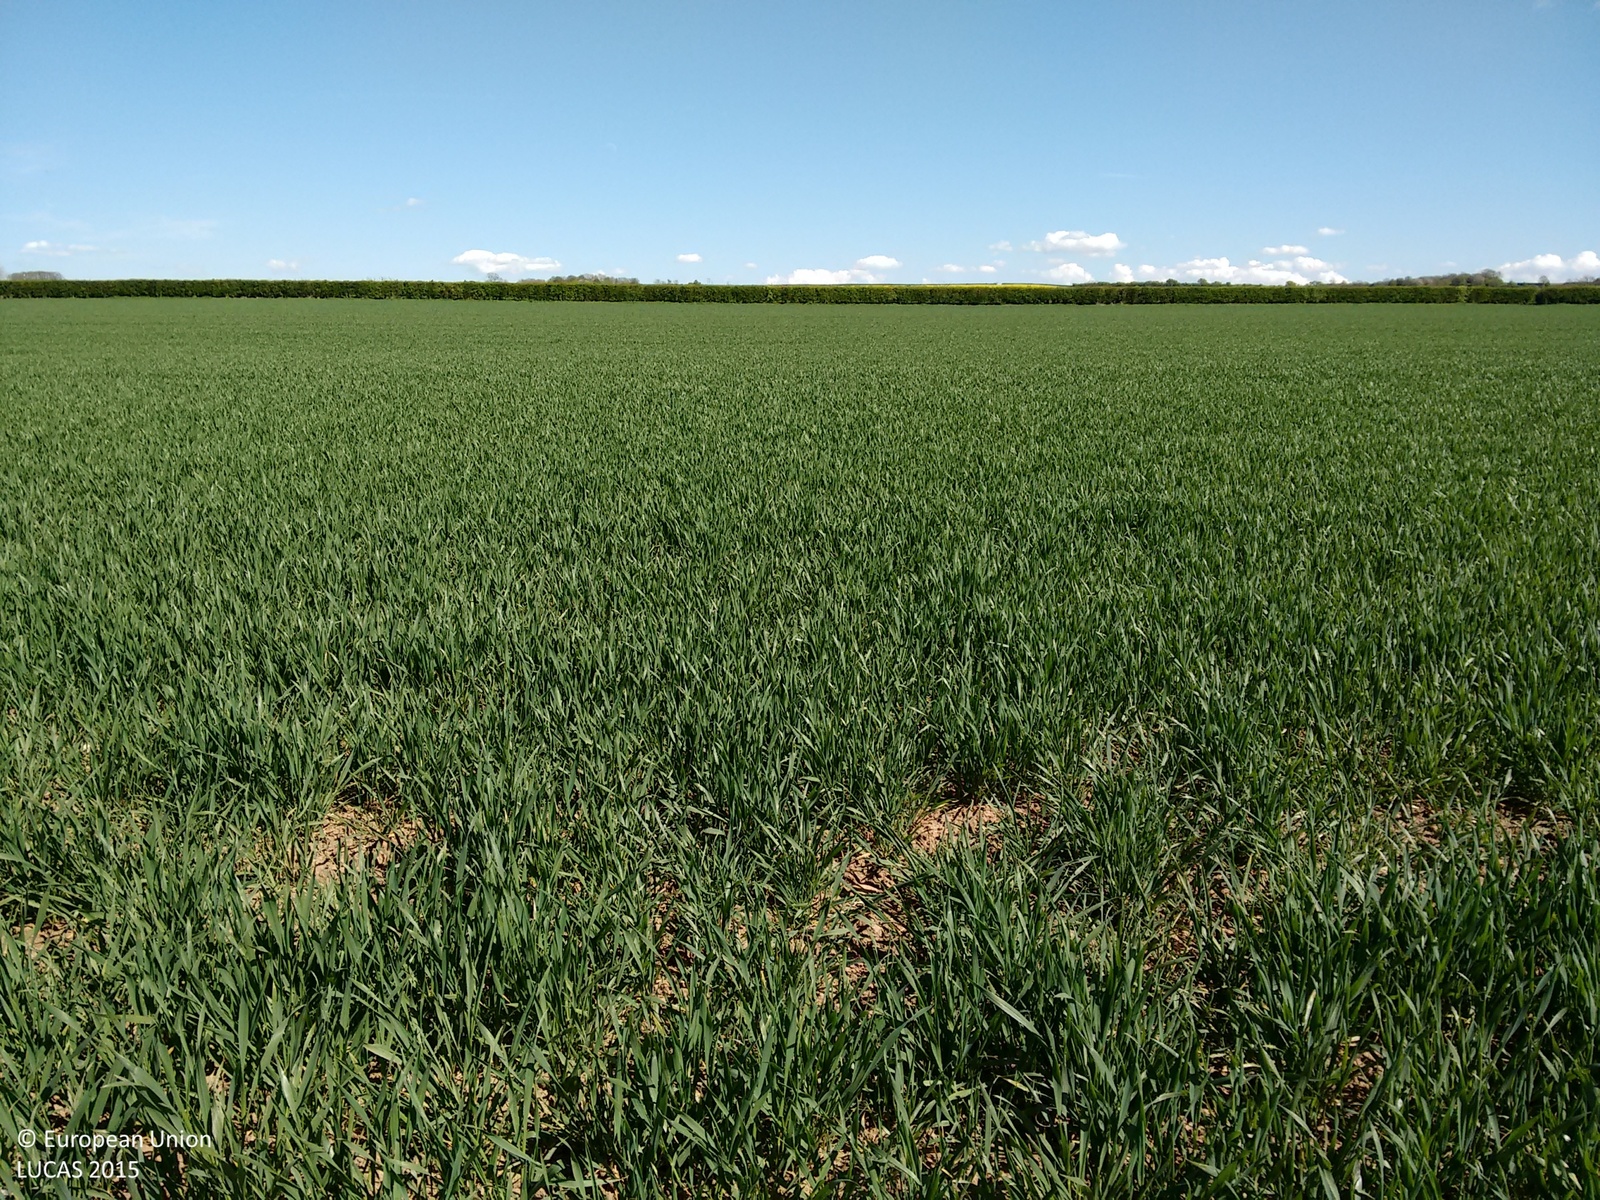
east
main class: Cropland
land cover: Barley
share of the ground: > 75 %
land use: Agriculture (excluding fallow land and kitchen gardens)
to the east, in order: Barley; Grass margins; Managed hedges; Grass margins; Paved roads, cycling and walking lanes; Grass margins; Managed hedges; Ditches and canals; Grassland without tree/shrub cover; Rape and turnip rape
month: April
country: GB
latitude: 53.2993
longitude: -0.5867
